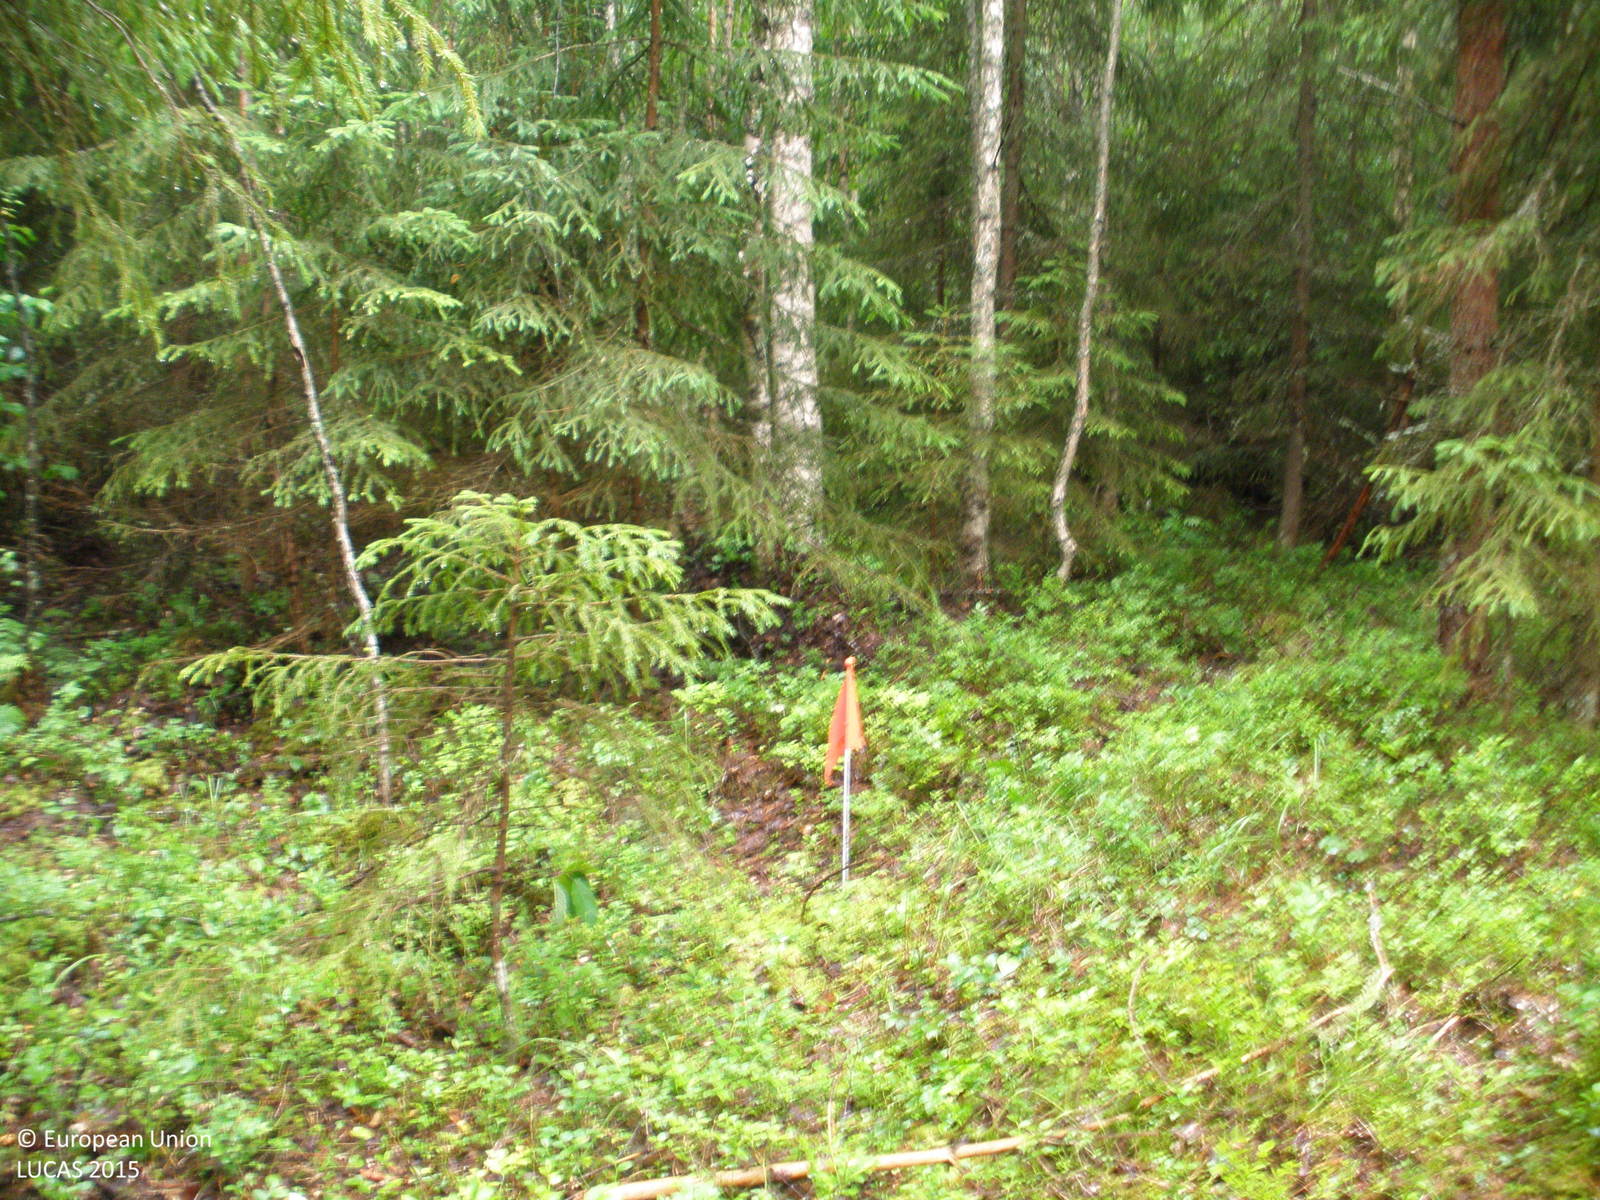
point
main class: Woodland
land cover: Spruce dominated mixed woodland
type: boreal forest
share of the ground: > 75 %
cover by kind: coniferous forest trees 40 %, broadleaved forest trees 35 %, herbaceous plants 15 %, lichens and mosses 5 %
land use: Forestry
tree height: > 5 m
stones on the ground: < 10 %
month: July
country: FI
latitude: 61.3956
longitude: 23.6961
